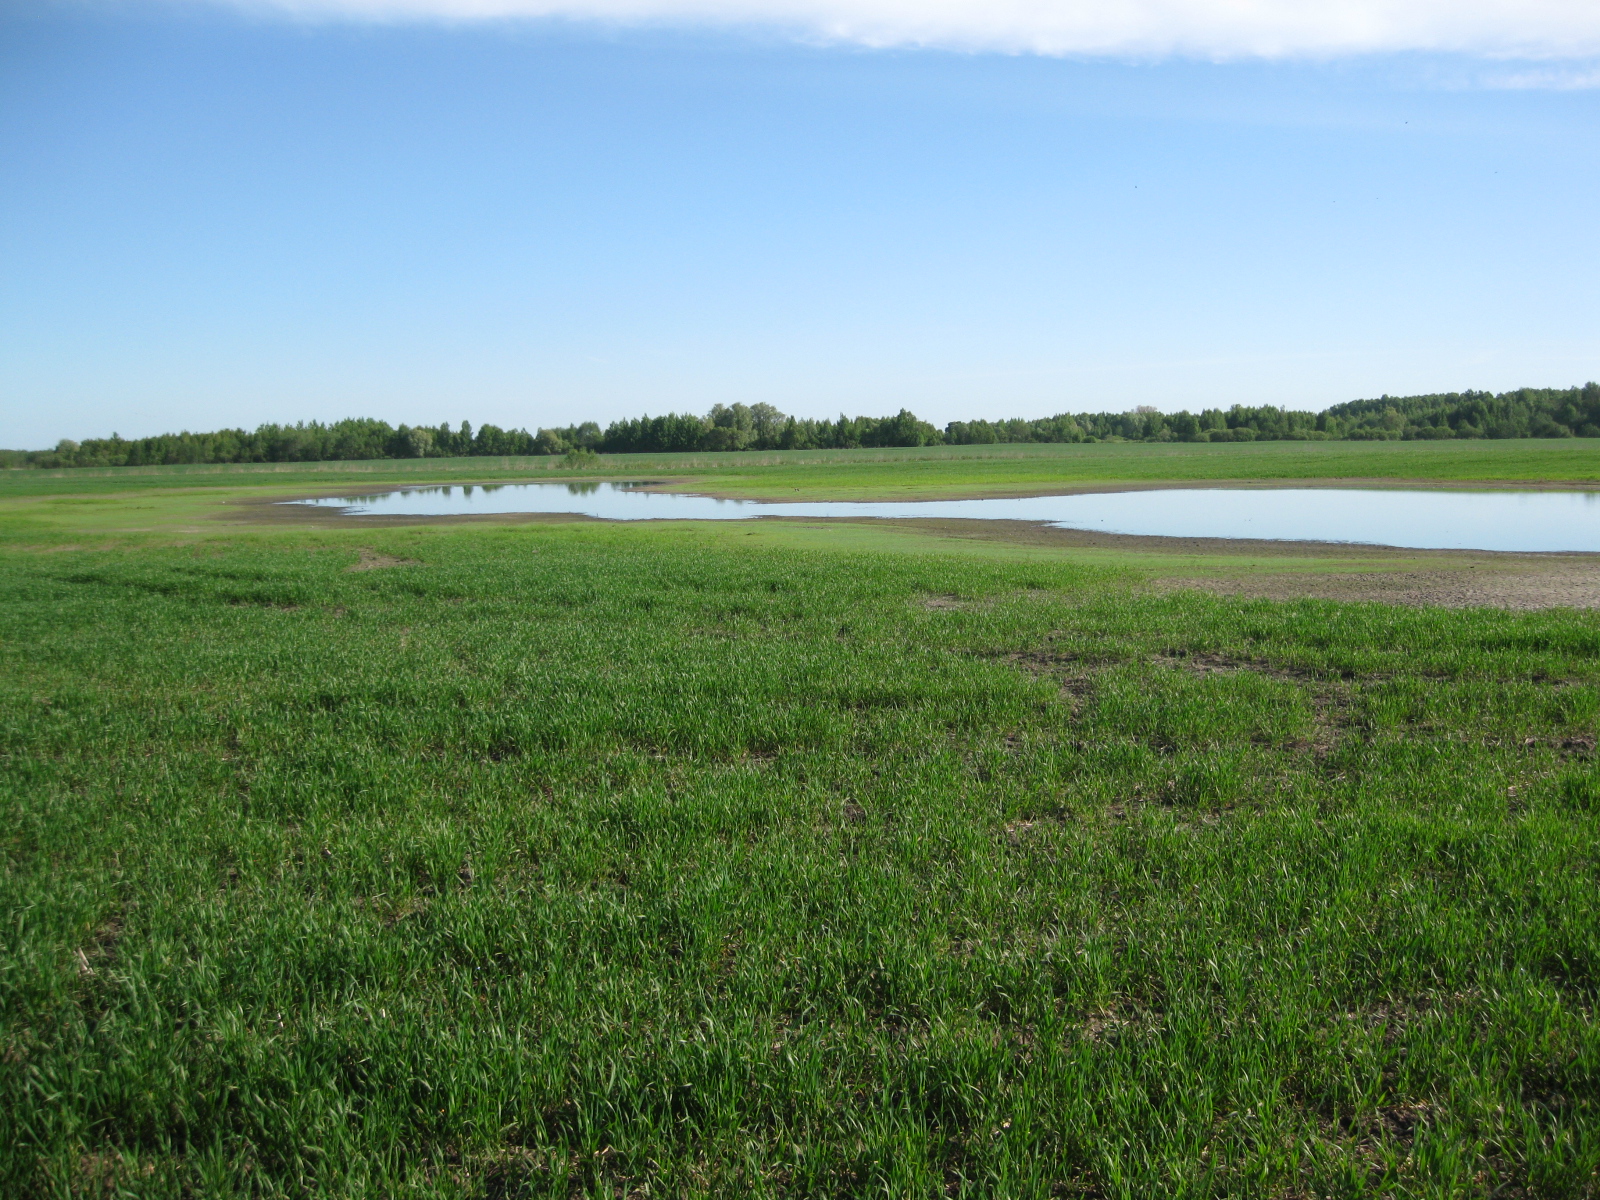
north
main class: Cropland
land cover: Common wheat
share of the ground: > 75 %
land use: Agriculture (excluding fallow land and kitchen gardens)
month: May
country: LT
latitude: 56.1698
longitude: 23.9524
